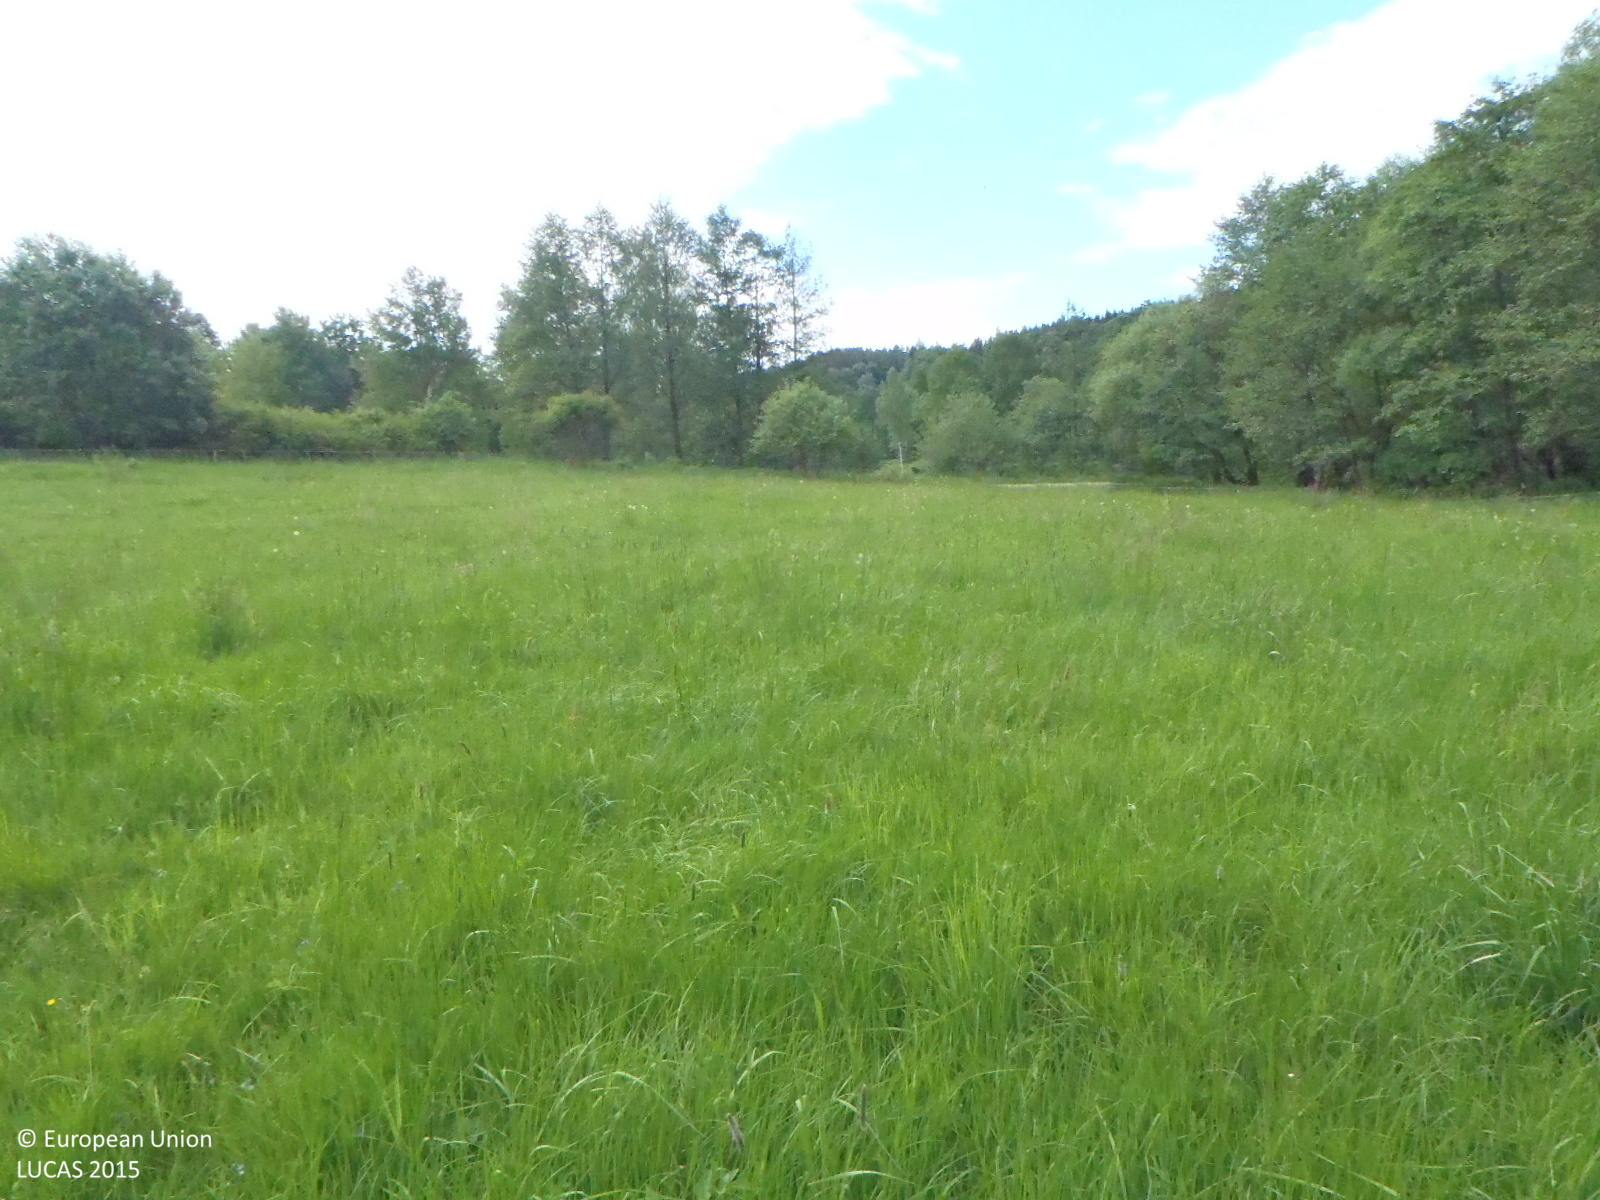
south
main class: Grassland
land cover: Grassland without tree/shrub cover
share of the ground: > 75 %
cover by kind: herbaceous plants 100 %
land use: Agriculture (excluding fallow land and kitchen gardens)
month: June
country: CZ
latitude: 48.6714
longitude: 14.5229
